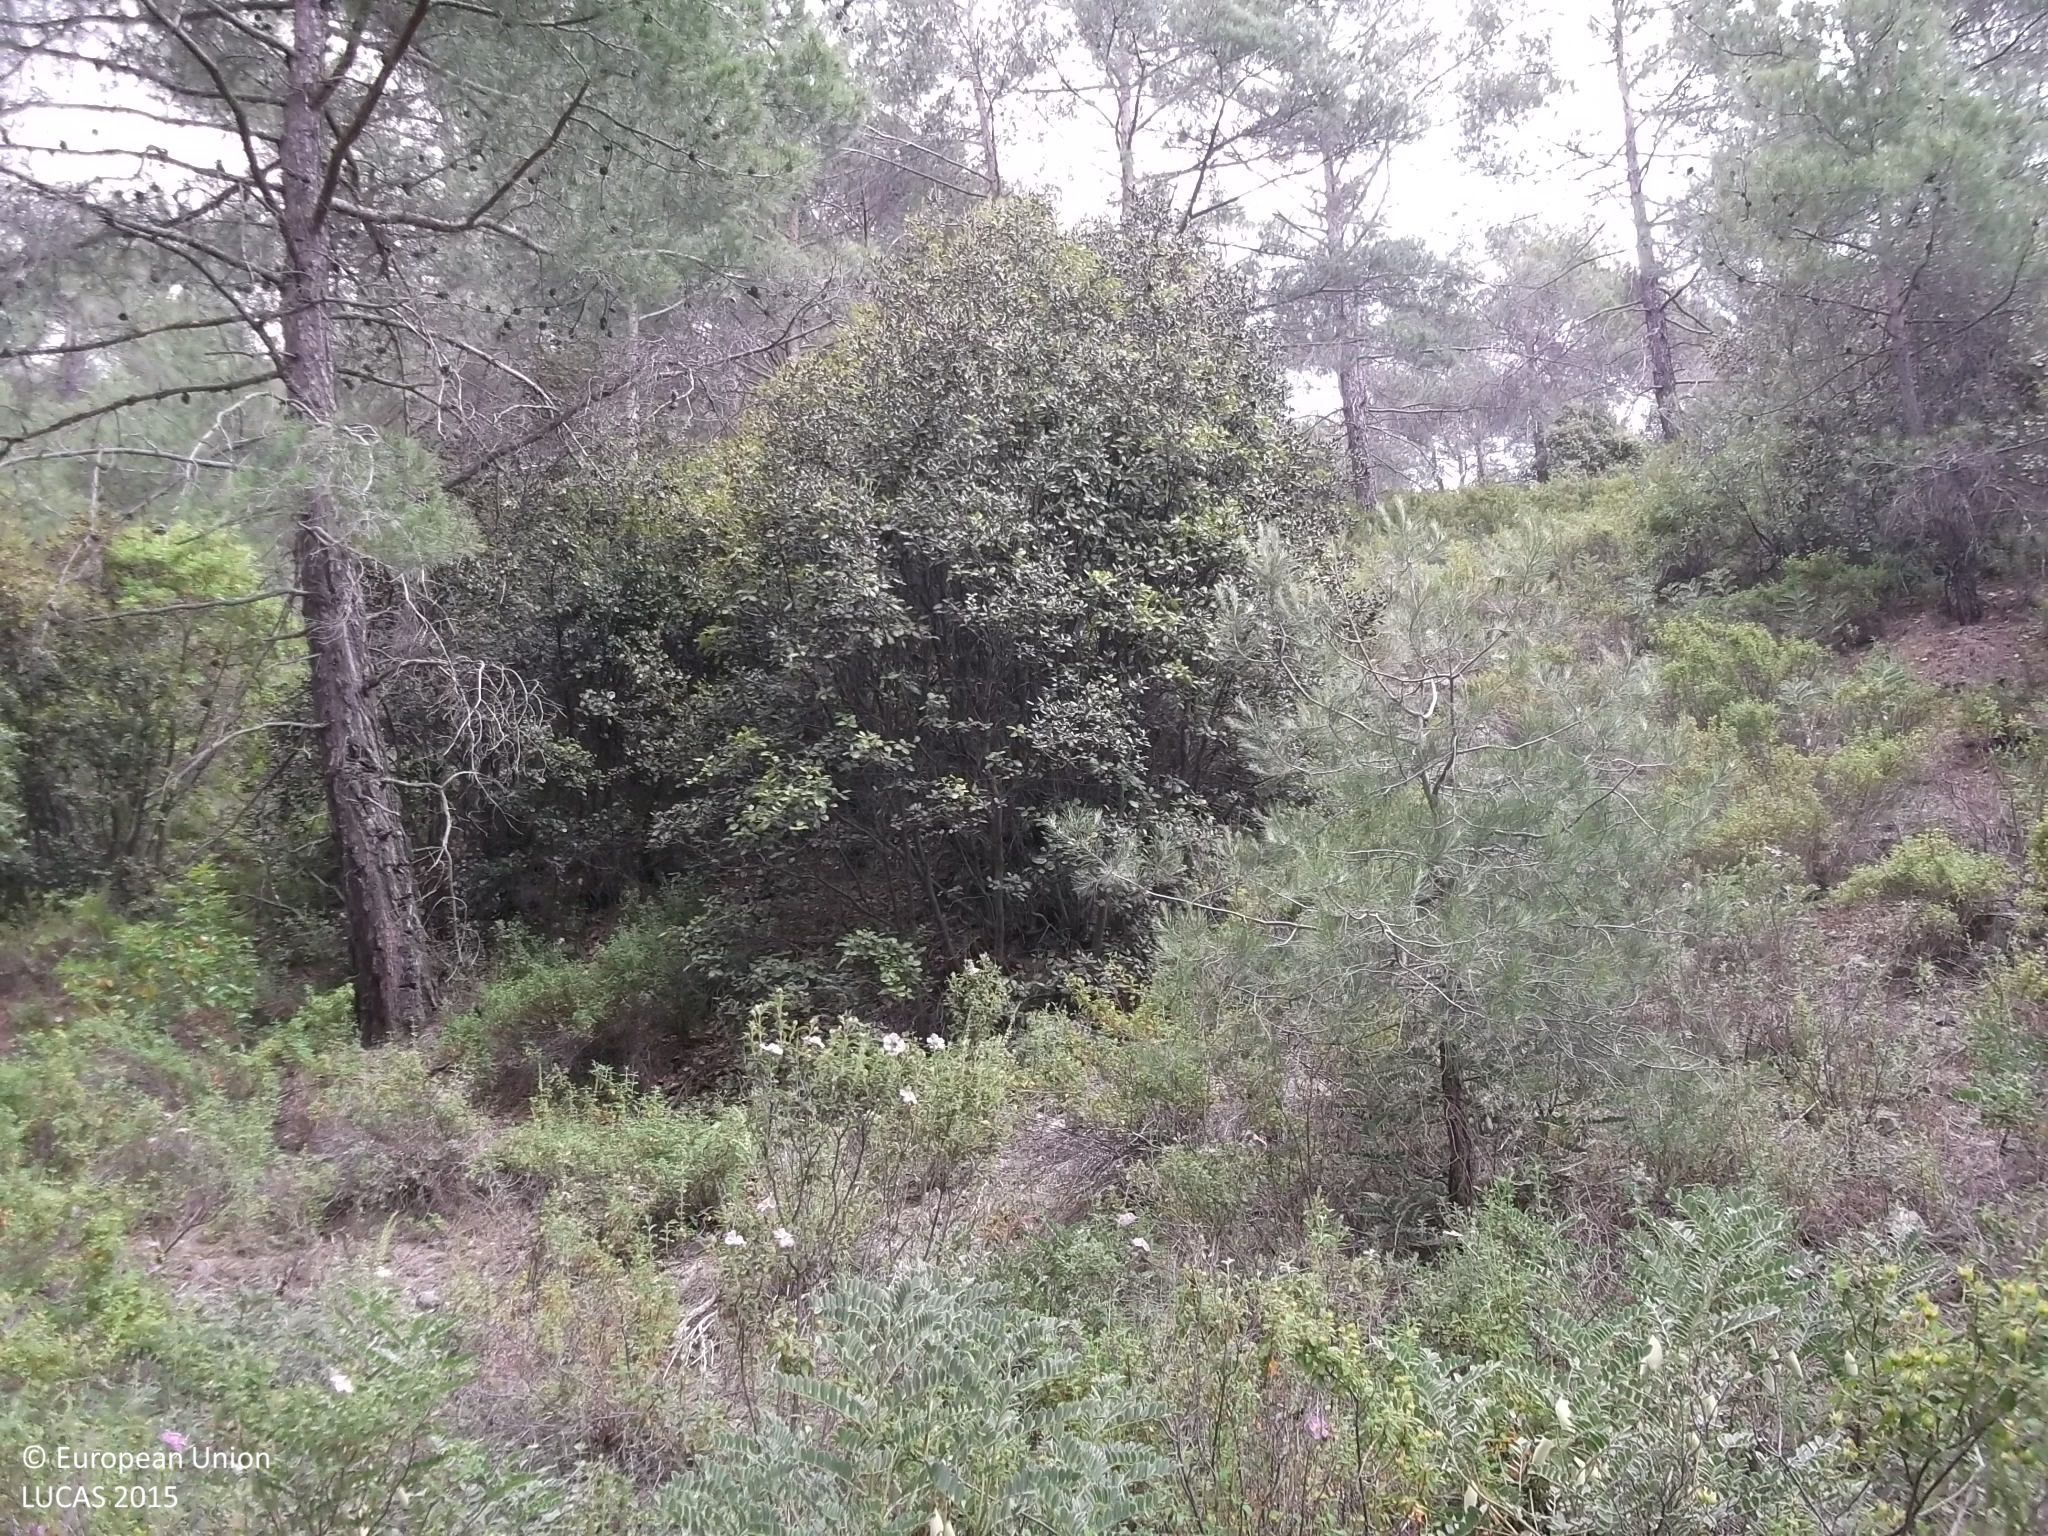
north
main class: Woodland
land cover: Pine dominated coniferous woodland
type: coniferous forest of the mediterranean region
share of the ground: > 75 %
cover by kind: coniferous forest trees 80 %, shrubs 15 %, unconsolidated bare surface 5 %
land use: Semi-natural and natural areas not in use
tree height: > 5 m
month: June
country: CY
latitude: 34.9198
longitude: 32.9480
